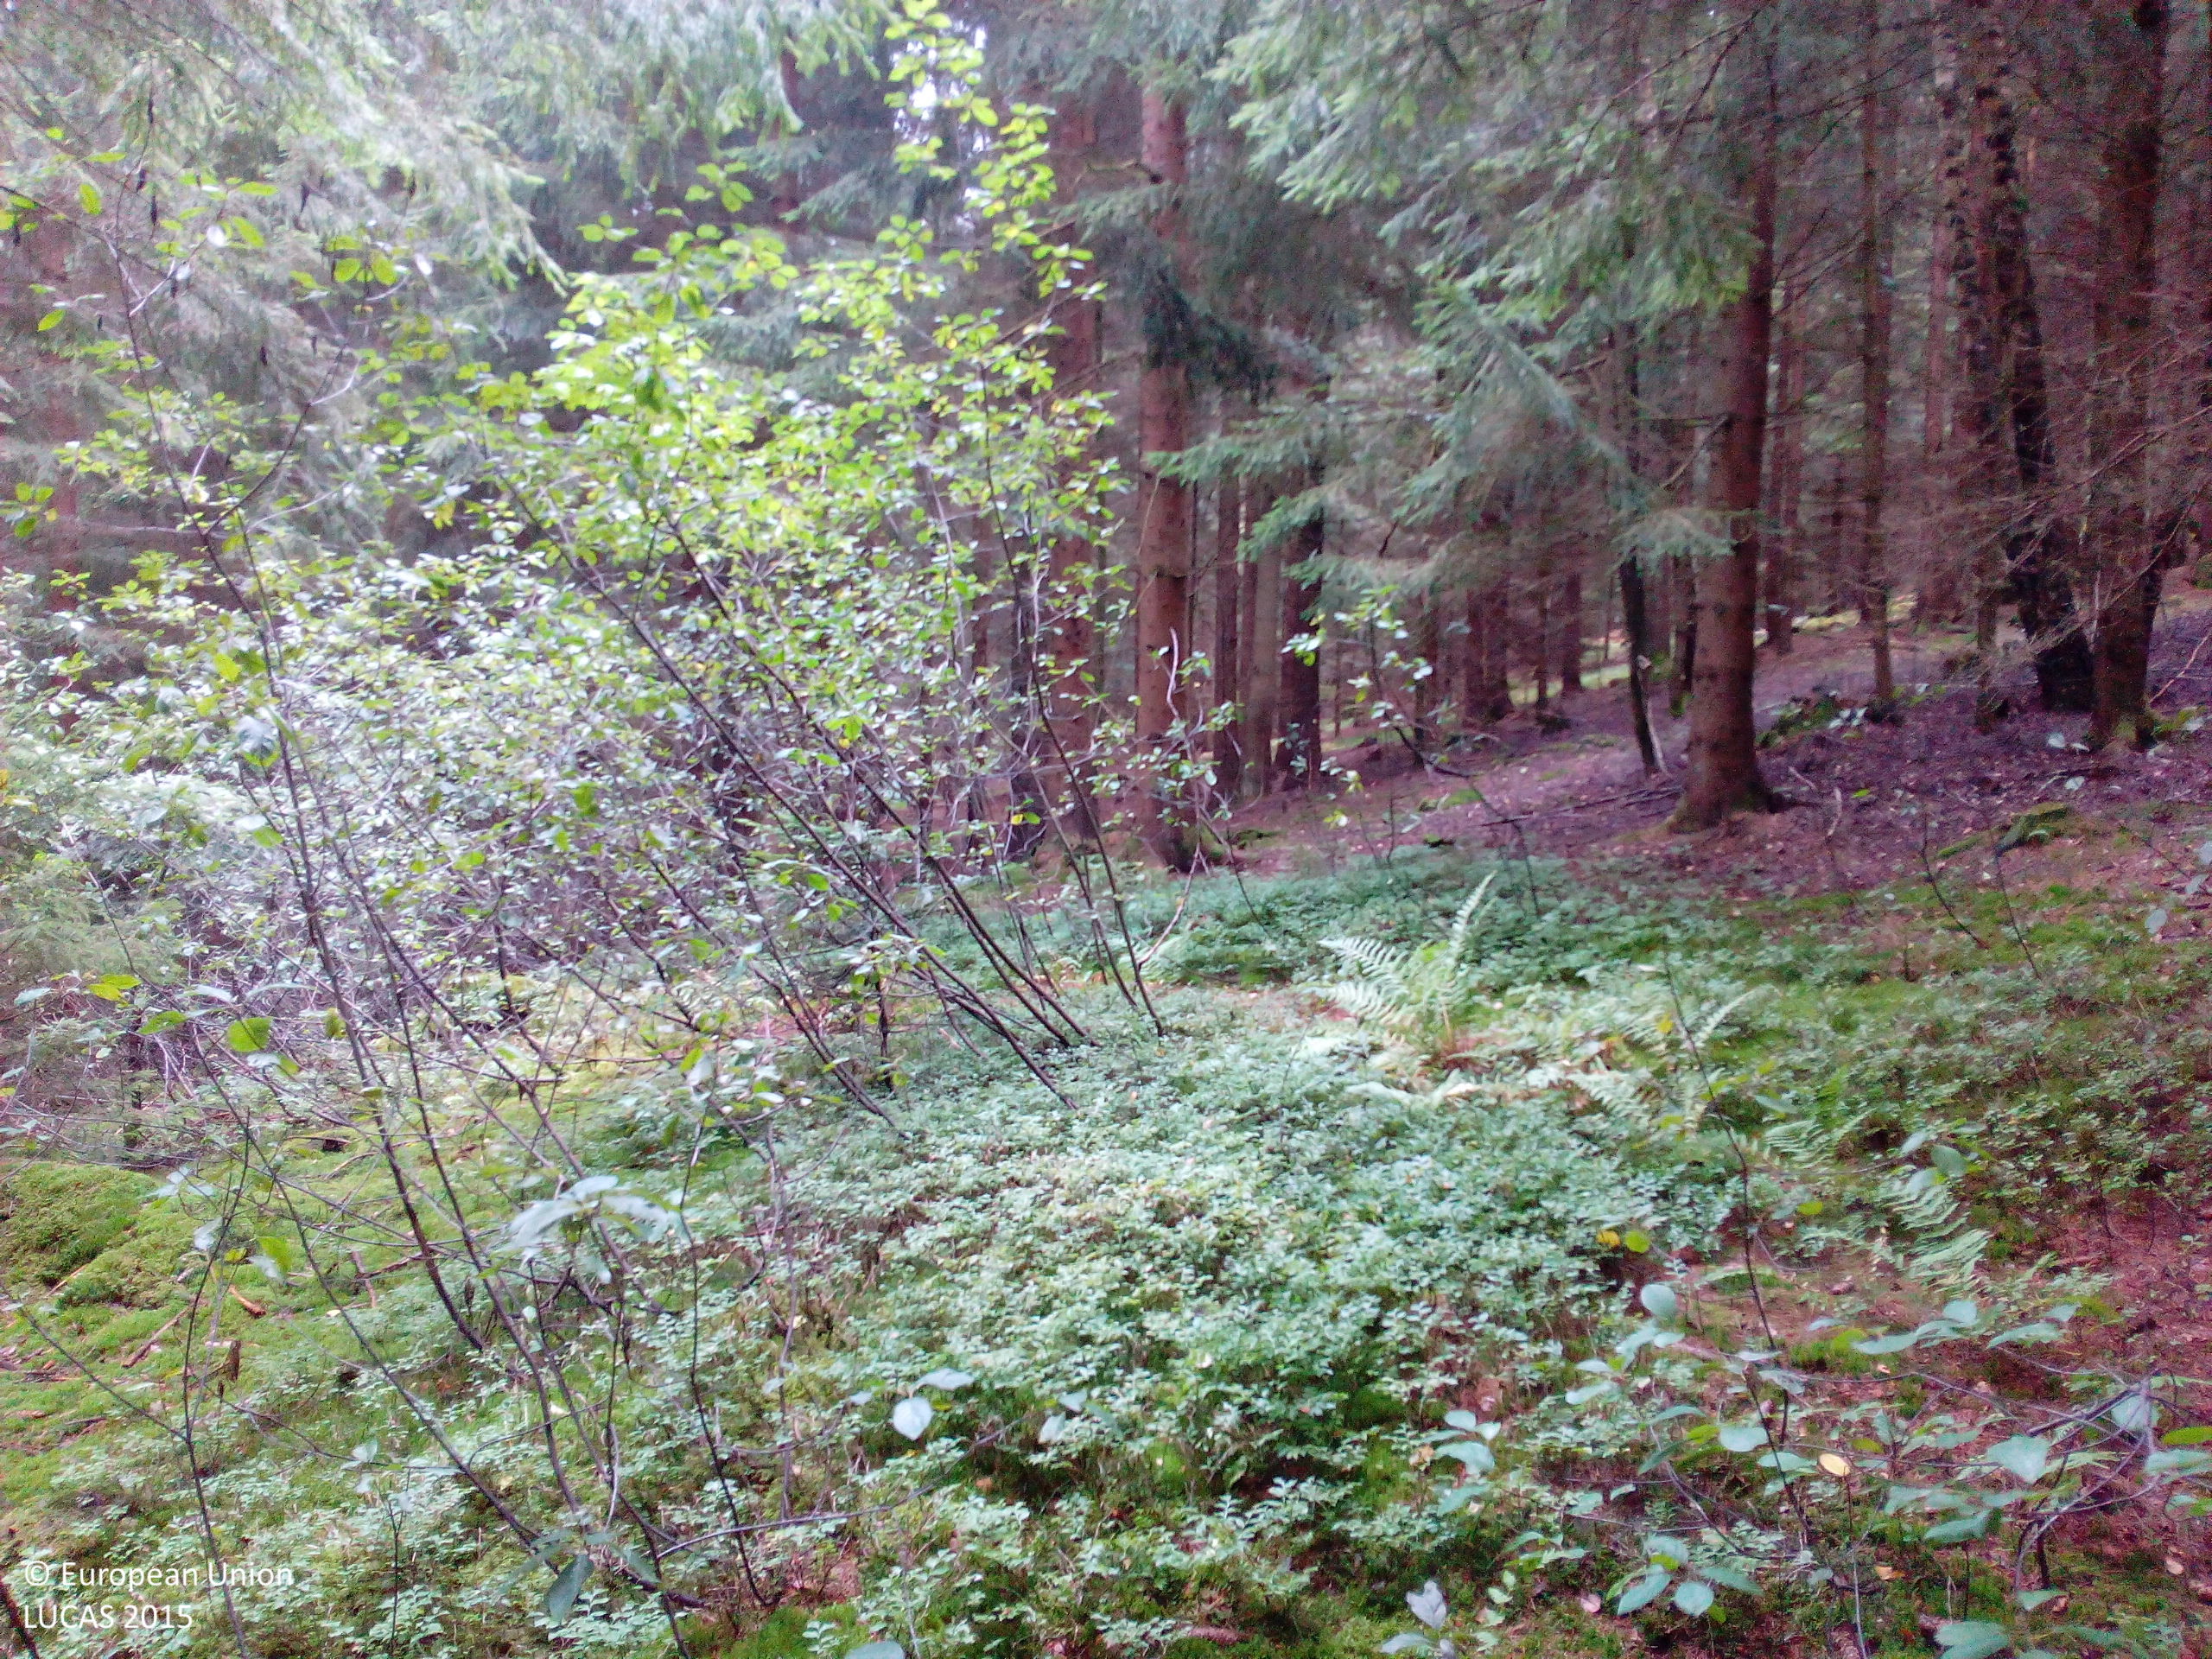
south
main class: Woodland
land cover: Spruce dominated coniferous woodland
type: hemiboreal forest and nemoral coniferous forest and mixed broadleaved-coniferous forest
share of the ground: > 75 %
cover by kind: coniferous forest trees 90 %, unconsolidated bare surface 10 %
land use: Forestry
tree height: > 5 m
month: September
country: DE
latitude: 48.9400
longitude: 12.9621
